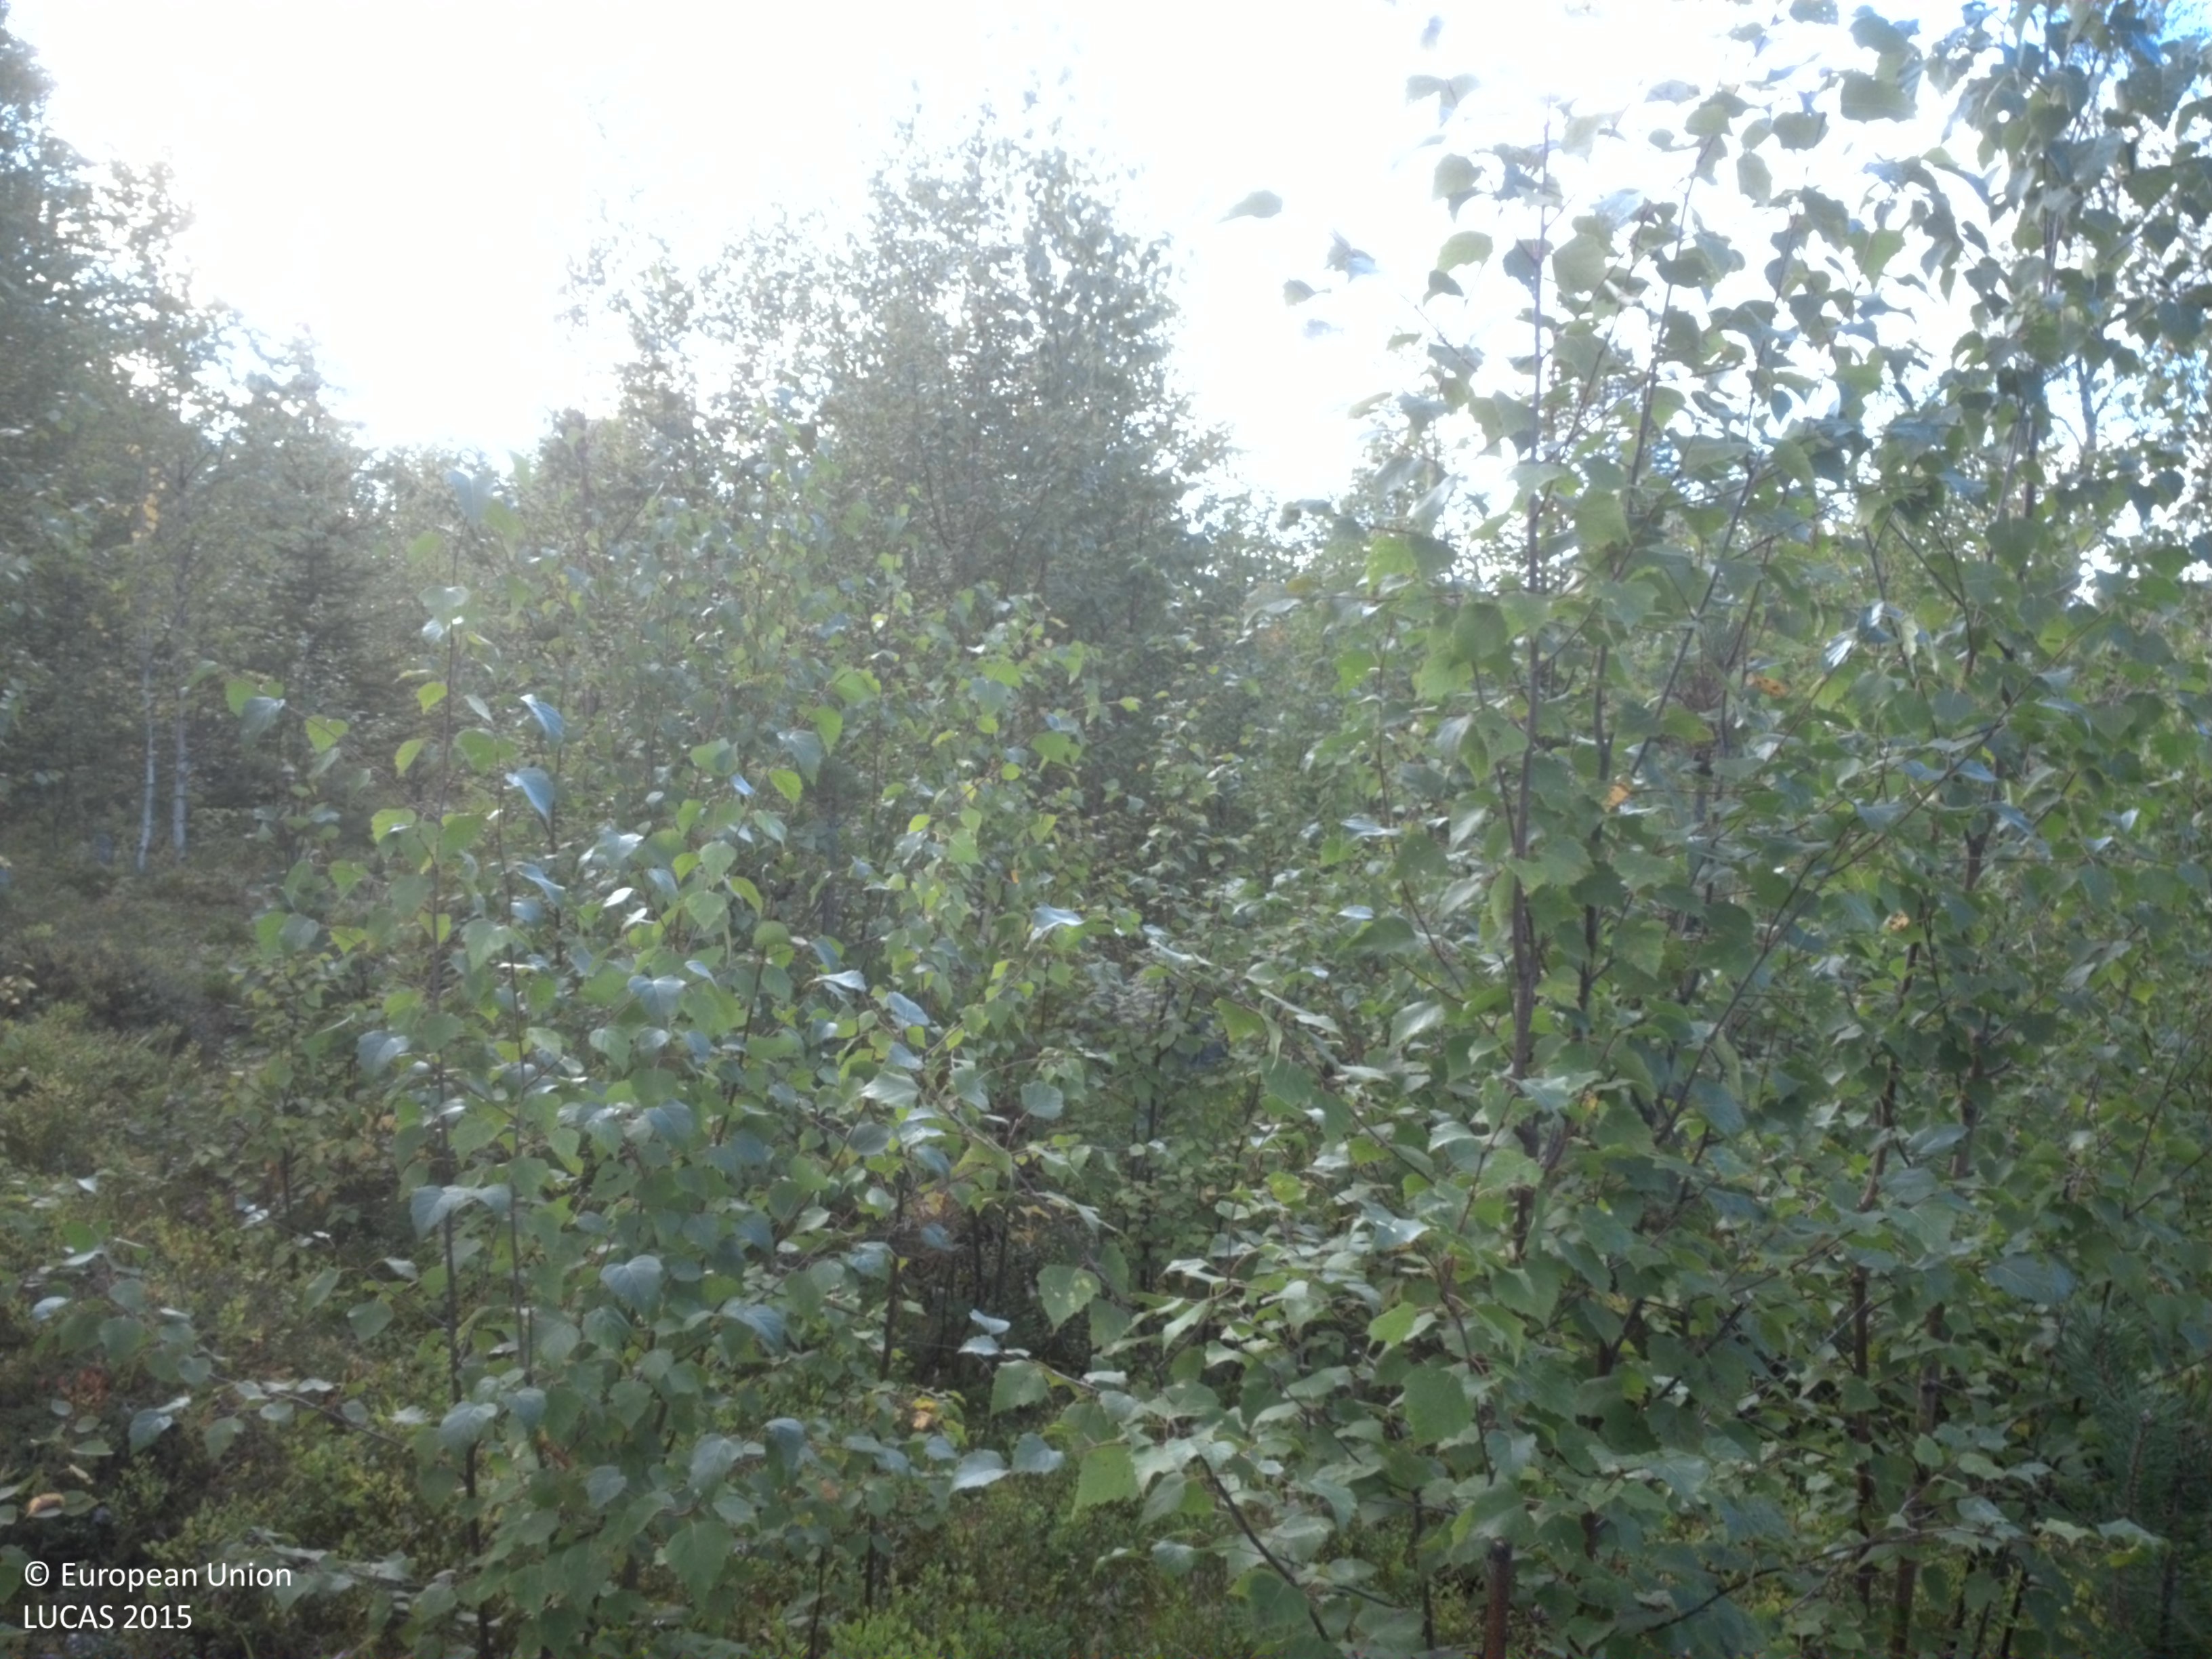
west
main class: Woodland
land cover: Broadleaved woodland
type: boreal forest
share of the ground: 50 - 75 %
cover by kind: broadleaved forest trees 60 %, shrubs 15 %, coniferous forest trees 10 %, lichens and mosses 10 %, herbaceous plants 5 %
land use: Forestry
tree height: > 5 m
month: September
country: SE
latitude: 64.4309
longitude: 19.0452
